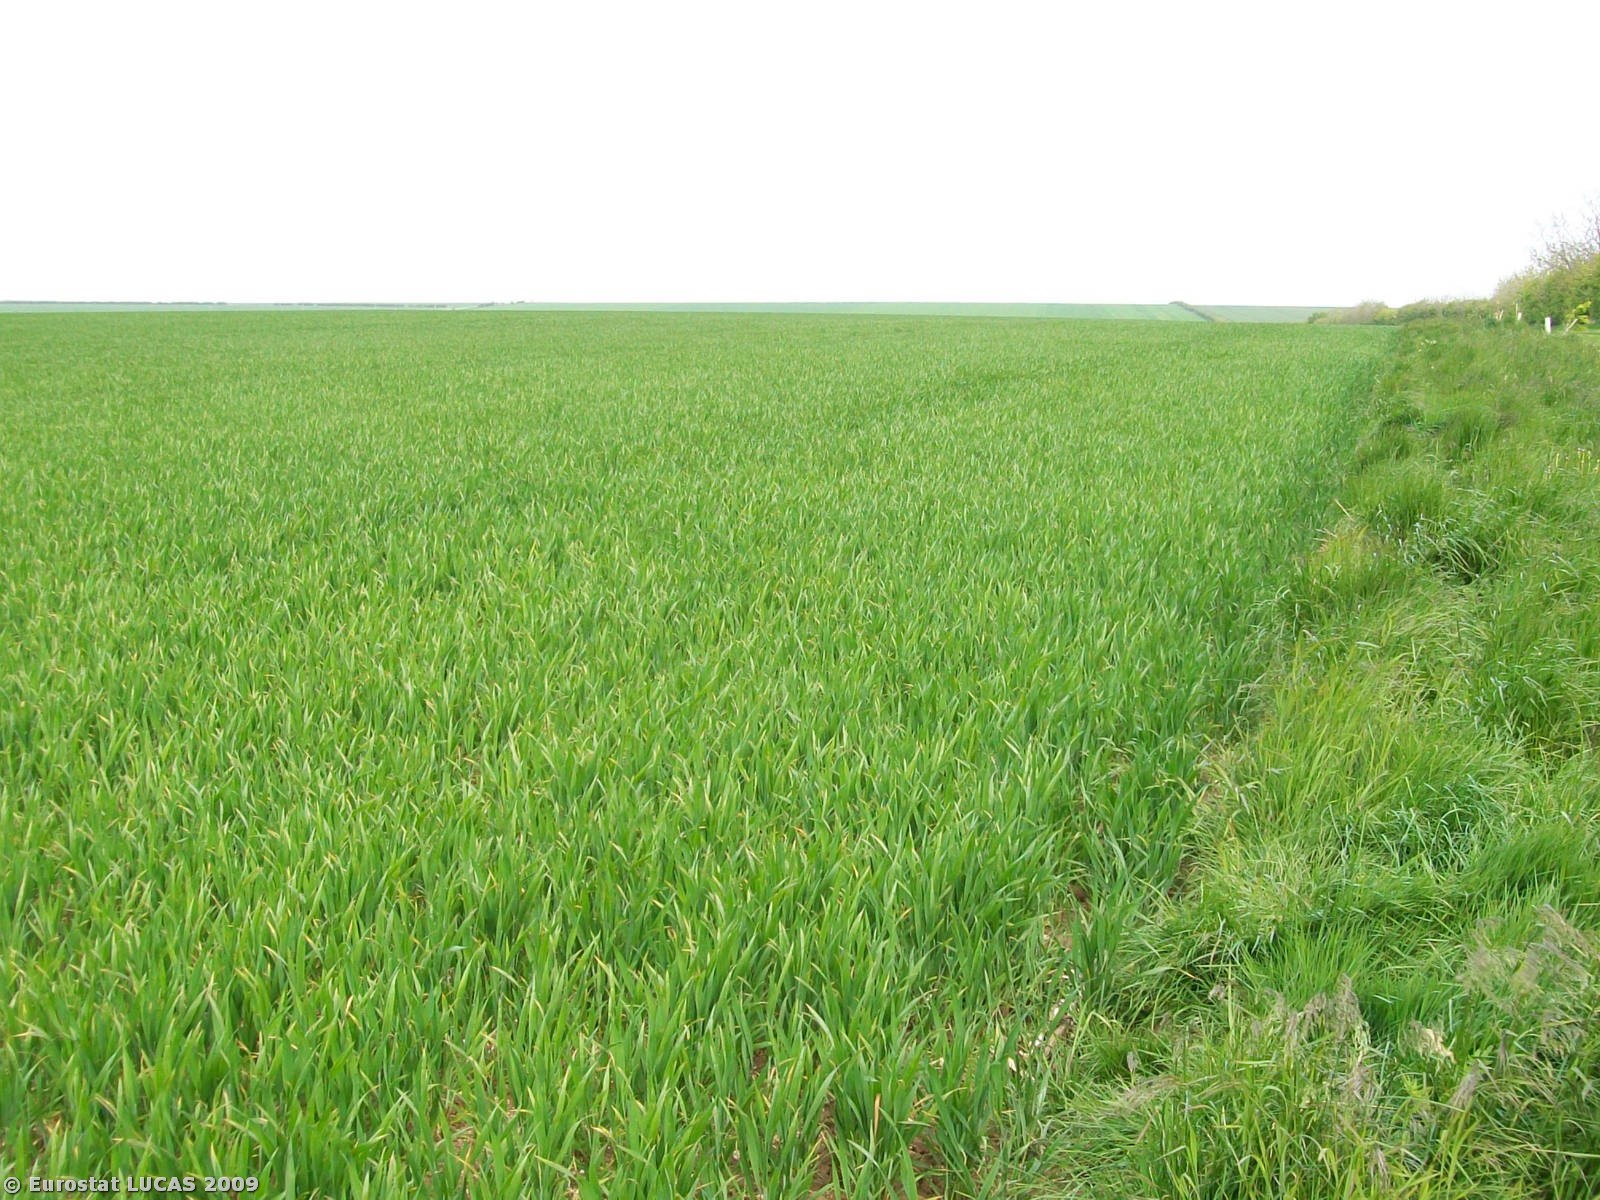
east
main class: Cropland
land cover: Common wheat
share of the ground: > 75 %
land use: Agriculture (excluding fallow land and kitchen gardens)
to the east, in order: Common wheat
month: May
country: GB
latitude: 54.1371
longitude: -0.3354
